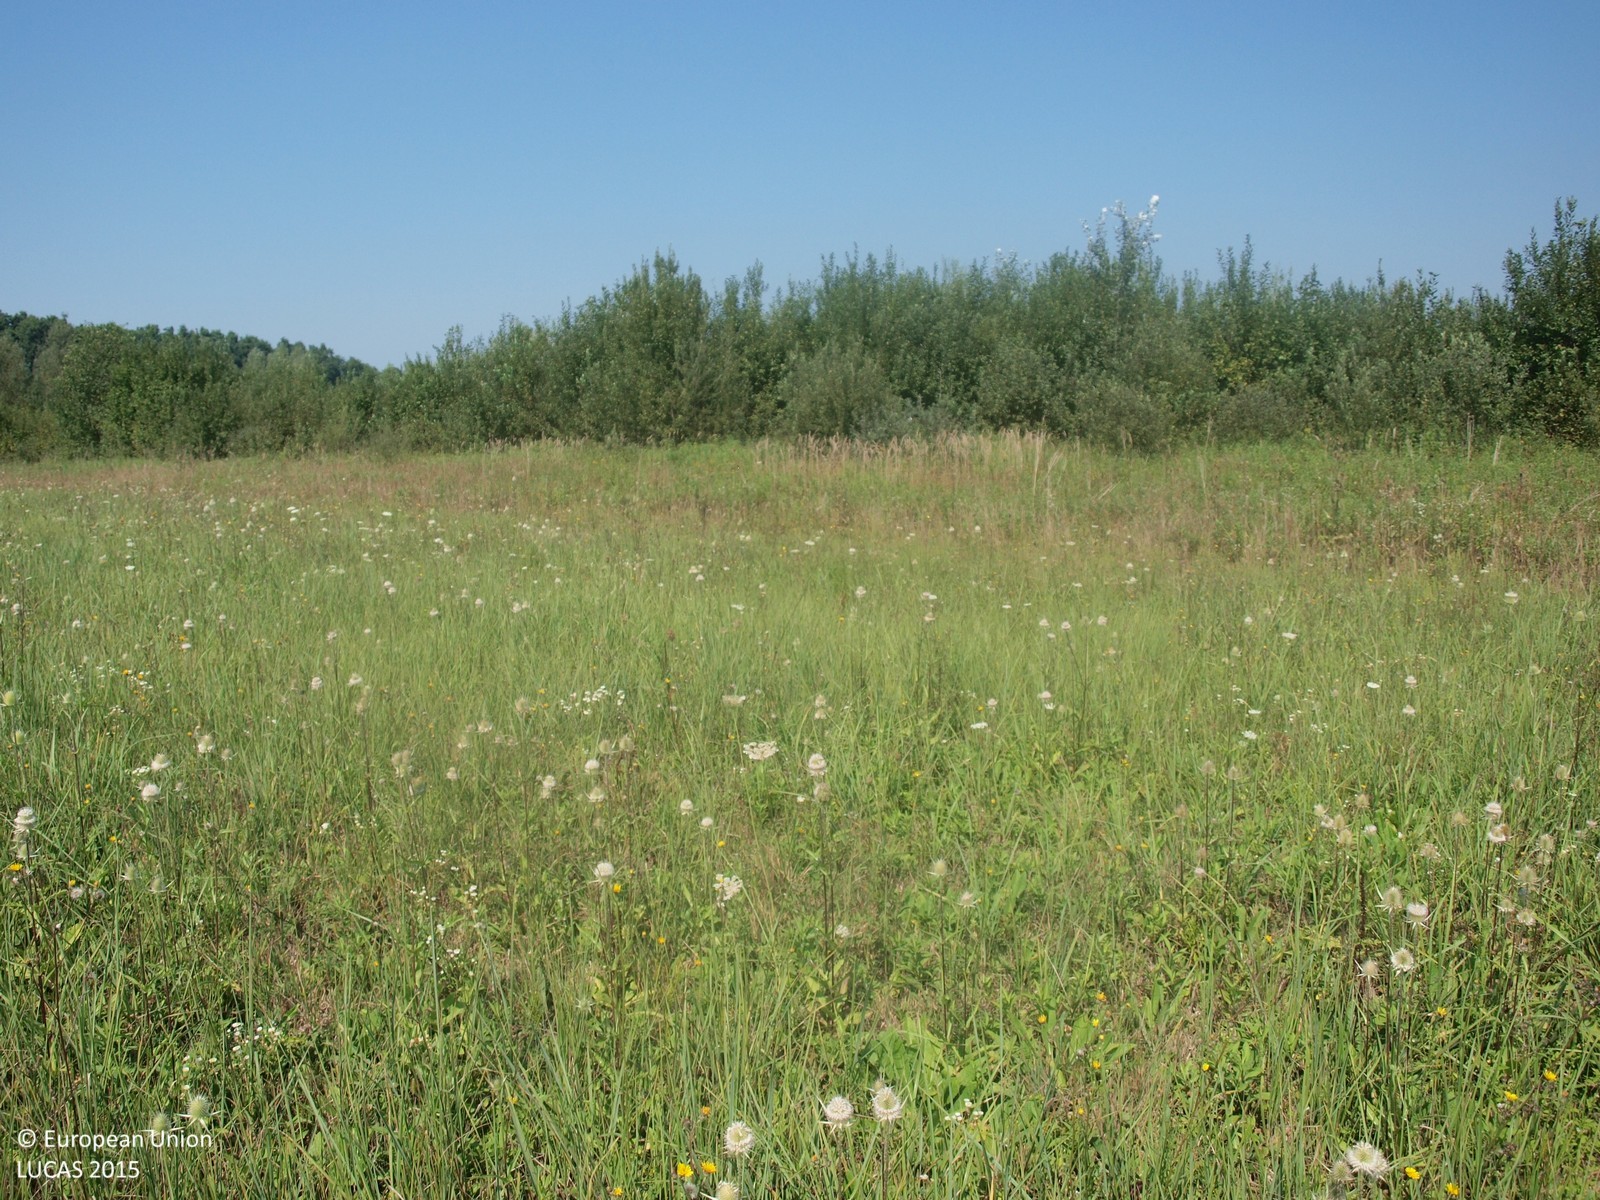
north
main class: Grassland
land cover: Grassland without tree/shrub cover
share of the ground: > 75 %
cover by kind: herbaceous plants 100 %
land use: Agriculture (excluding fallow land and kitchen gardens)
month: August
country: HR
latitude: 45.6667
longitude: 16.4806
